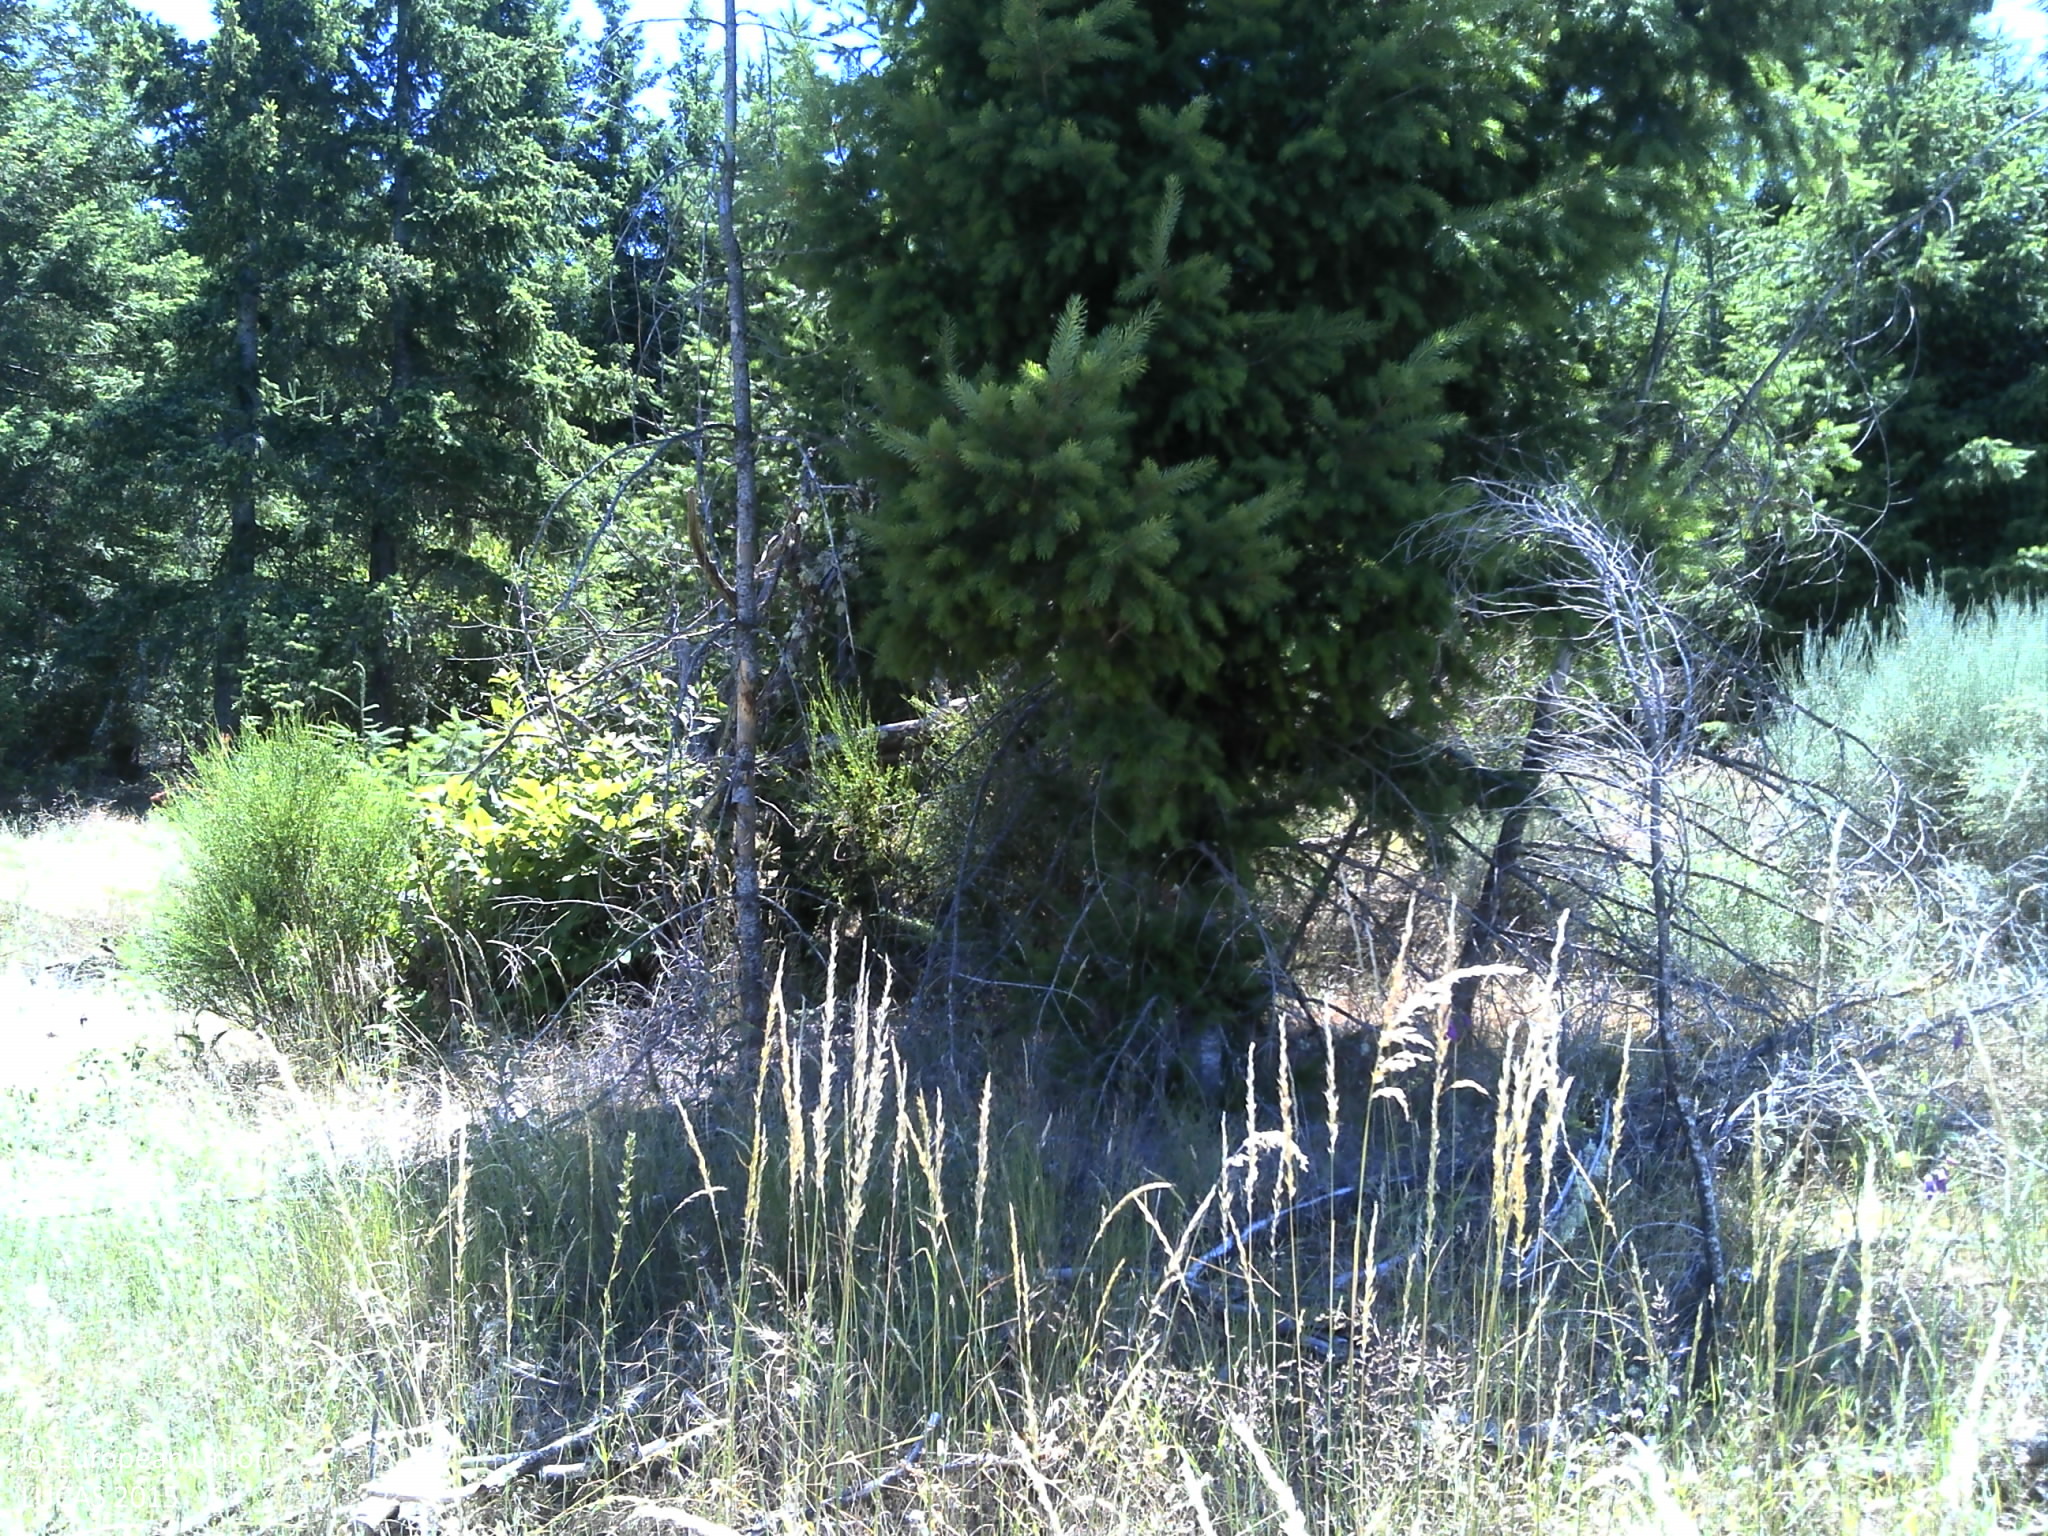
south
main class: Shrubland
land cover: Shrubland with sparse tree cover
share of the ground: > 75 %
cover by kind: shrubs 90 %, coniferous forest trees 5 %, herbaceous plants 5 %
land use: Abandoned areas
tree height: < 5 m
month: June
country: PT
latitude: 41.4652
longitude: -6.9837
